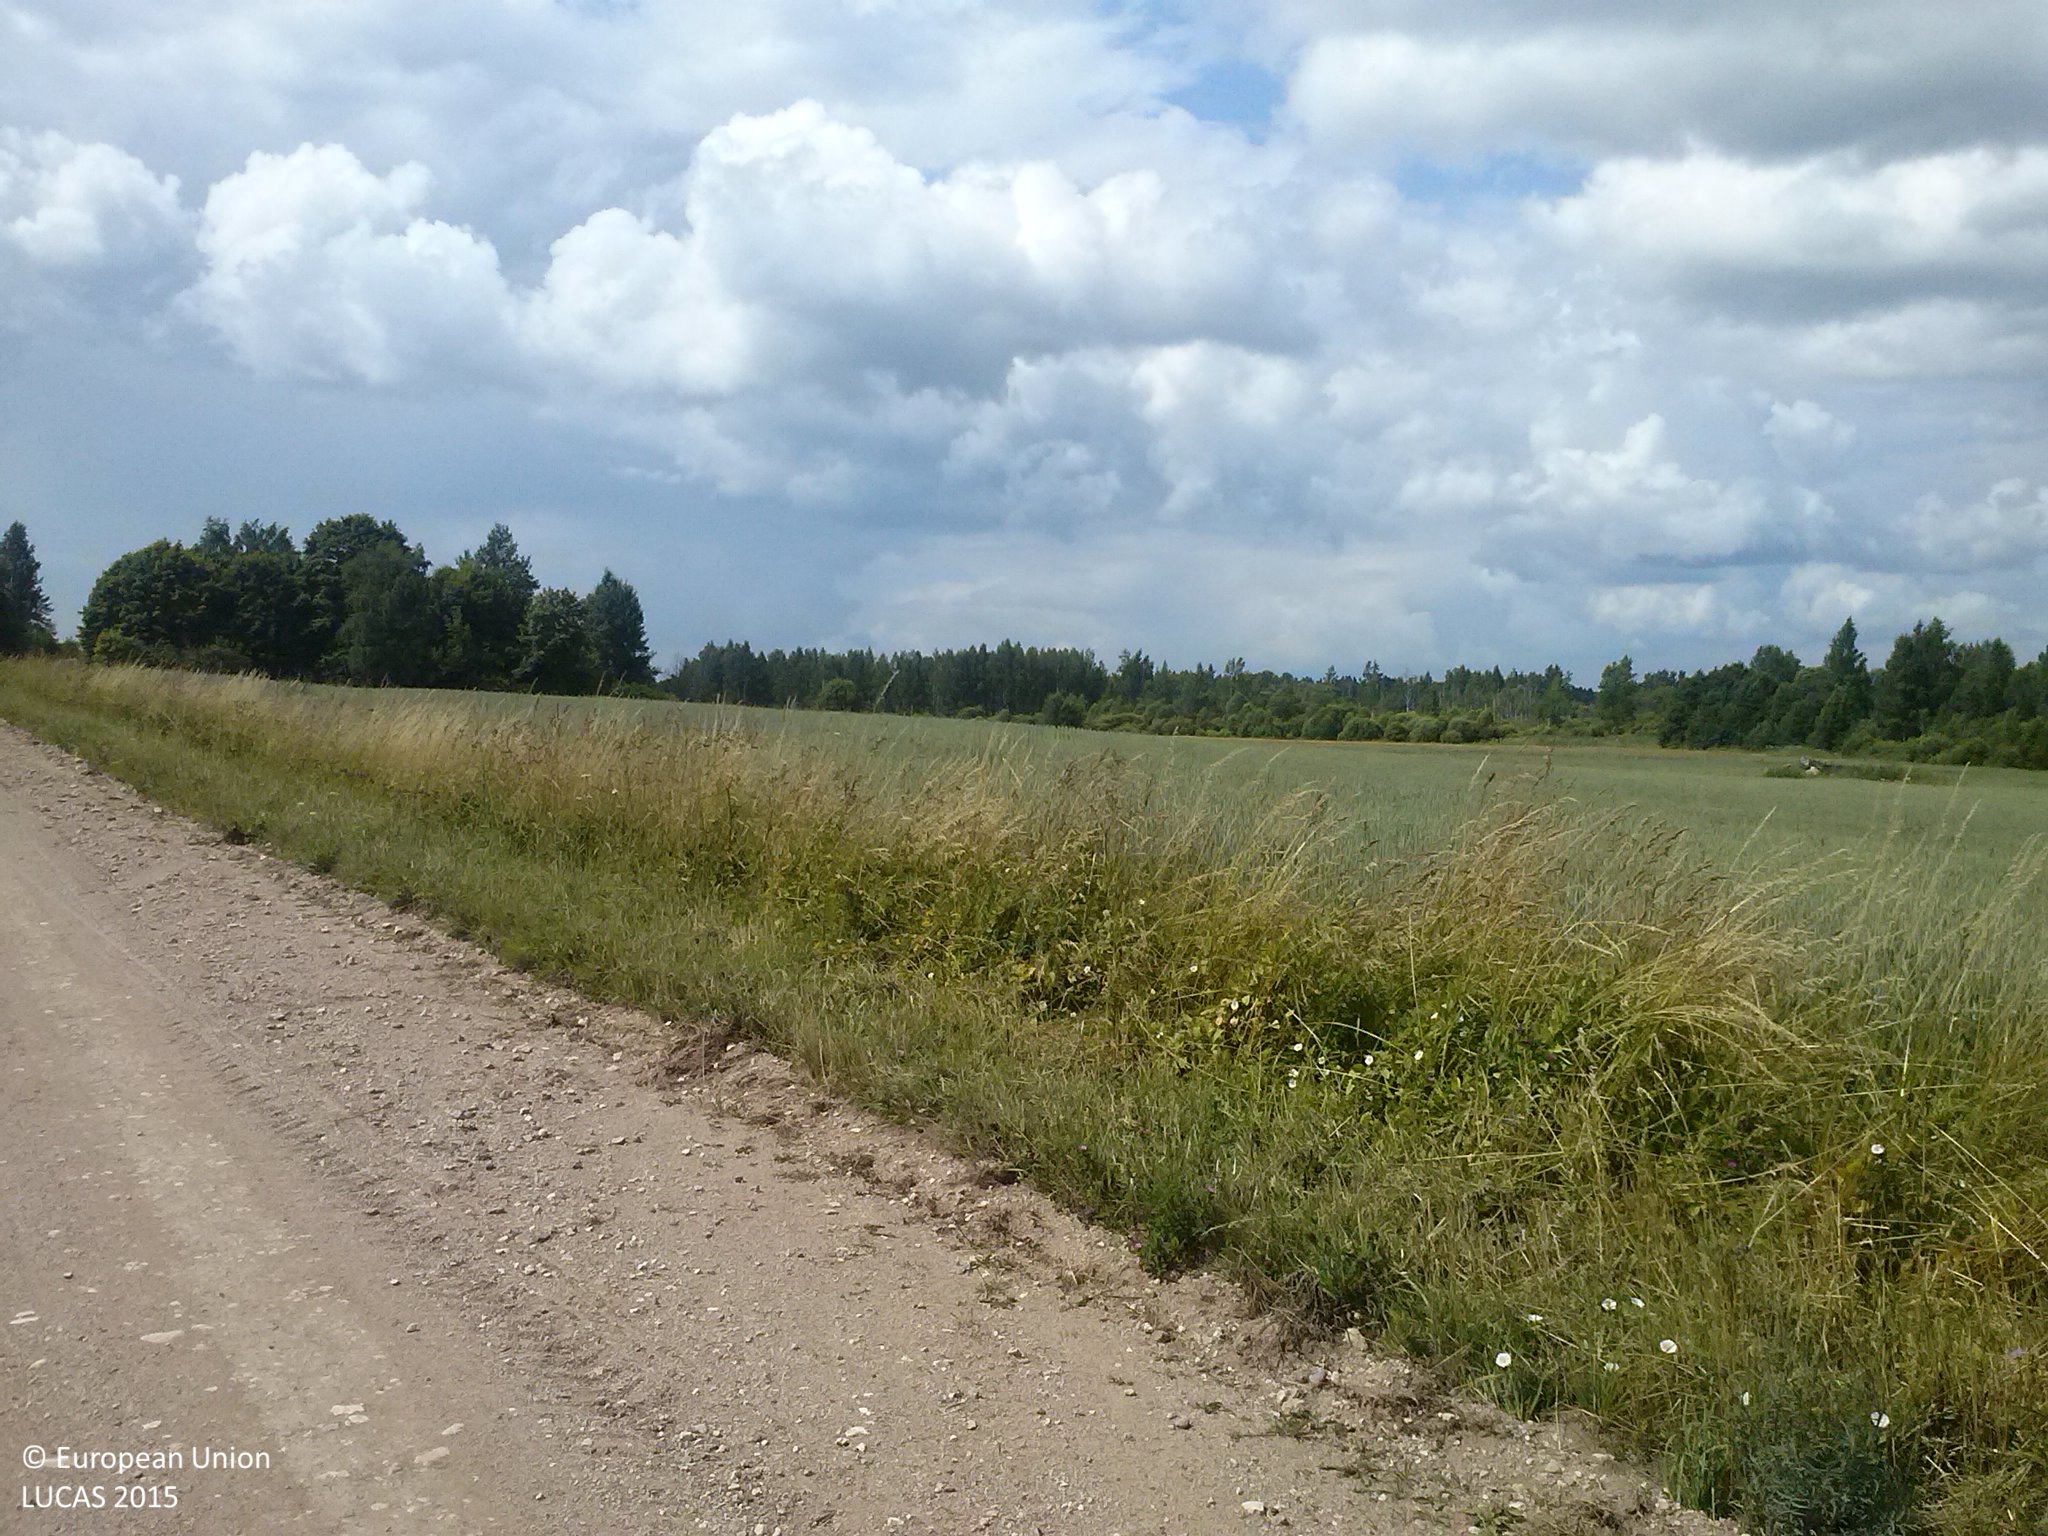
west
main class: Cropland
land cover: Durum wheat
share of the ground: > 75 %
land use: Agriculture (excluding fallow land and kitchen gardens)
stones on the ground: < 10 %
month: July
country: LV
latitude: 56.7176
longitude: 27.5482
